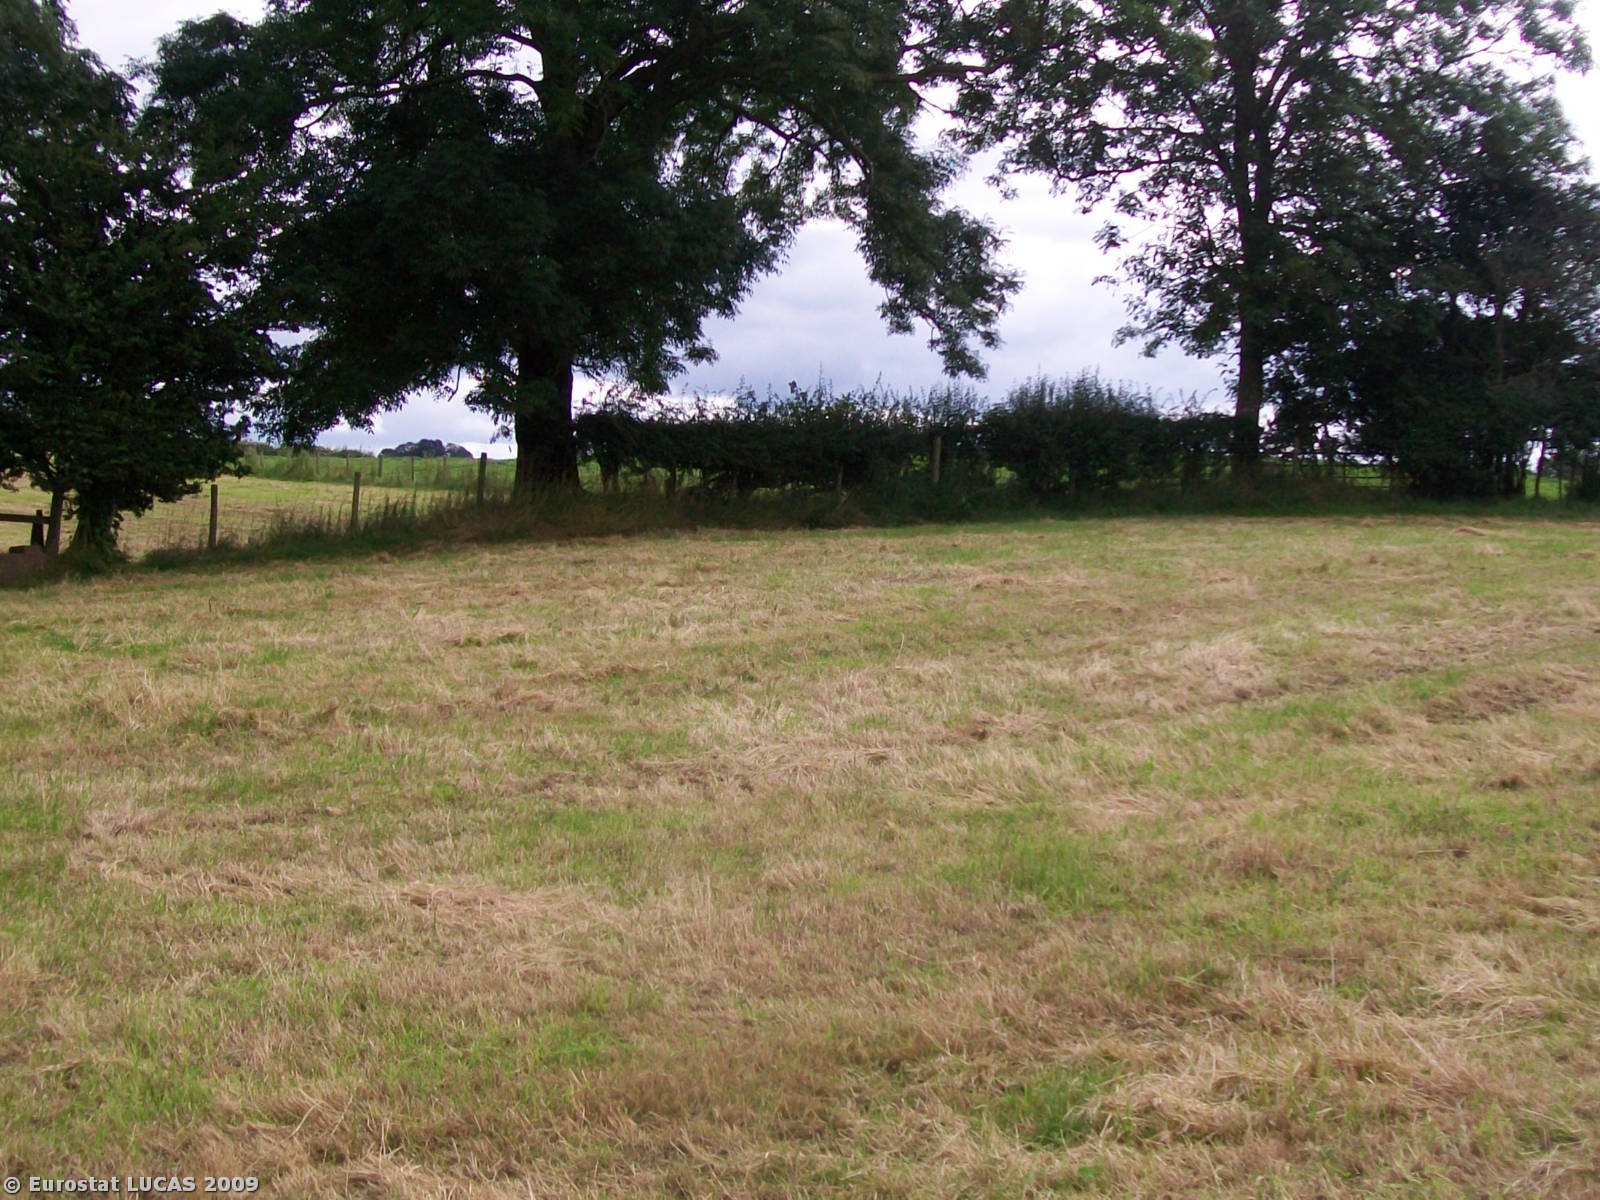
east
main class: Grassland
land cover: Grassland without tree/shrub cover
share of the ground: > 75 %
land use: Agriculture (excluding fallow land and kitchen gardens)
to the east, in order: Grassland without tree/shrub cover; Managed hedges; Grassland without tree/shrub cover; Fences; Grassland without tree/shrub cover; Managed hedges; Grassland without tree/shrub cover
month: August
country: GB
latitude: 52.6030
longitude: -3.3556
